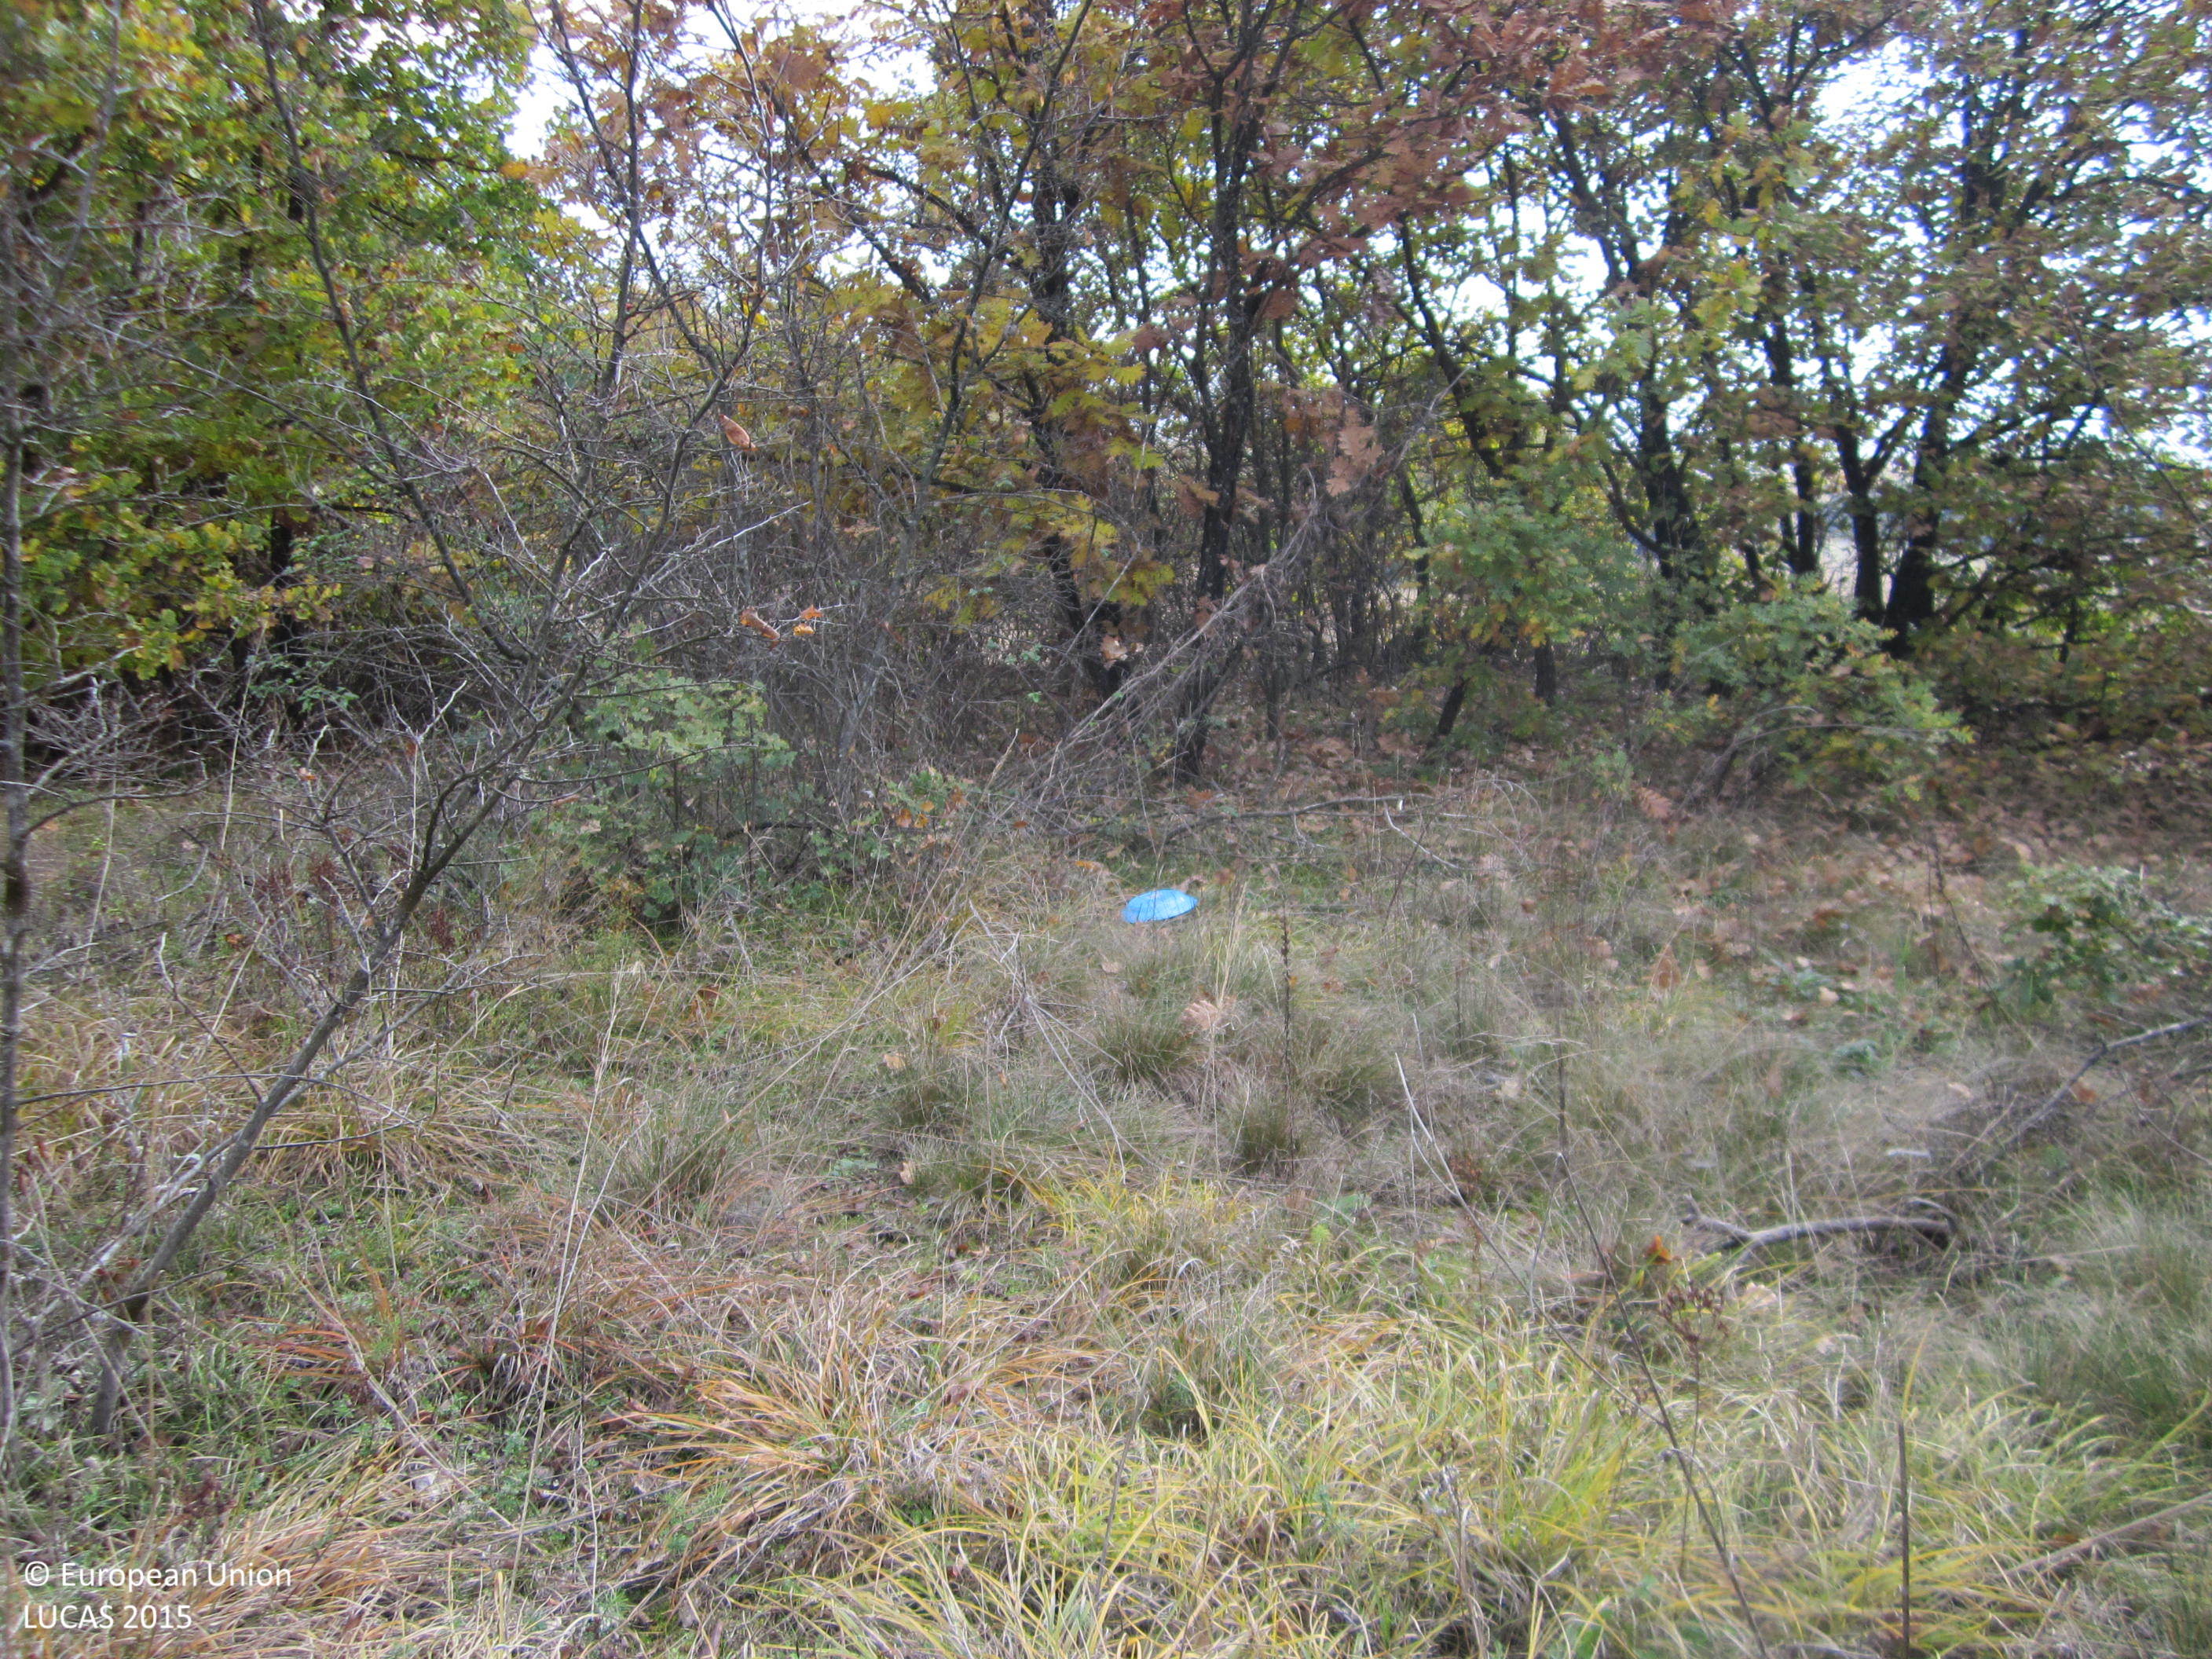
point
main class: Woodland
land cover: Broadleaved woodland
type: mesophytic deciduous forest
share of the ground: > 75 %
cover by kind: broadleaved forest trees 90 %, shrubs 5 %, unconsolidated bare surface 5 %
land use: Forestry
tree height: > 5 m
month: November
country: BG
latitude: 42.5594
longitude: 24.8570
